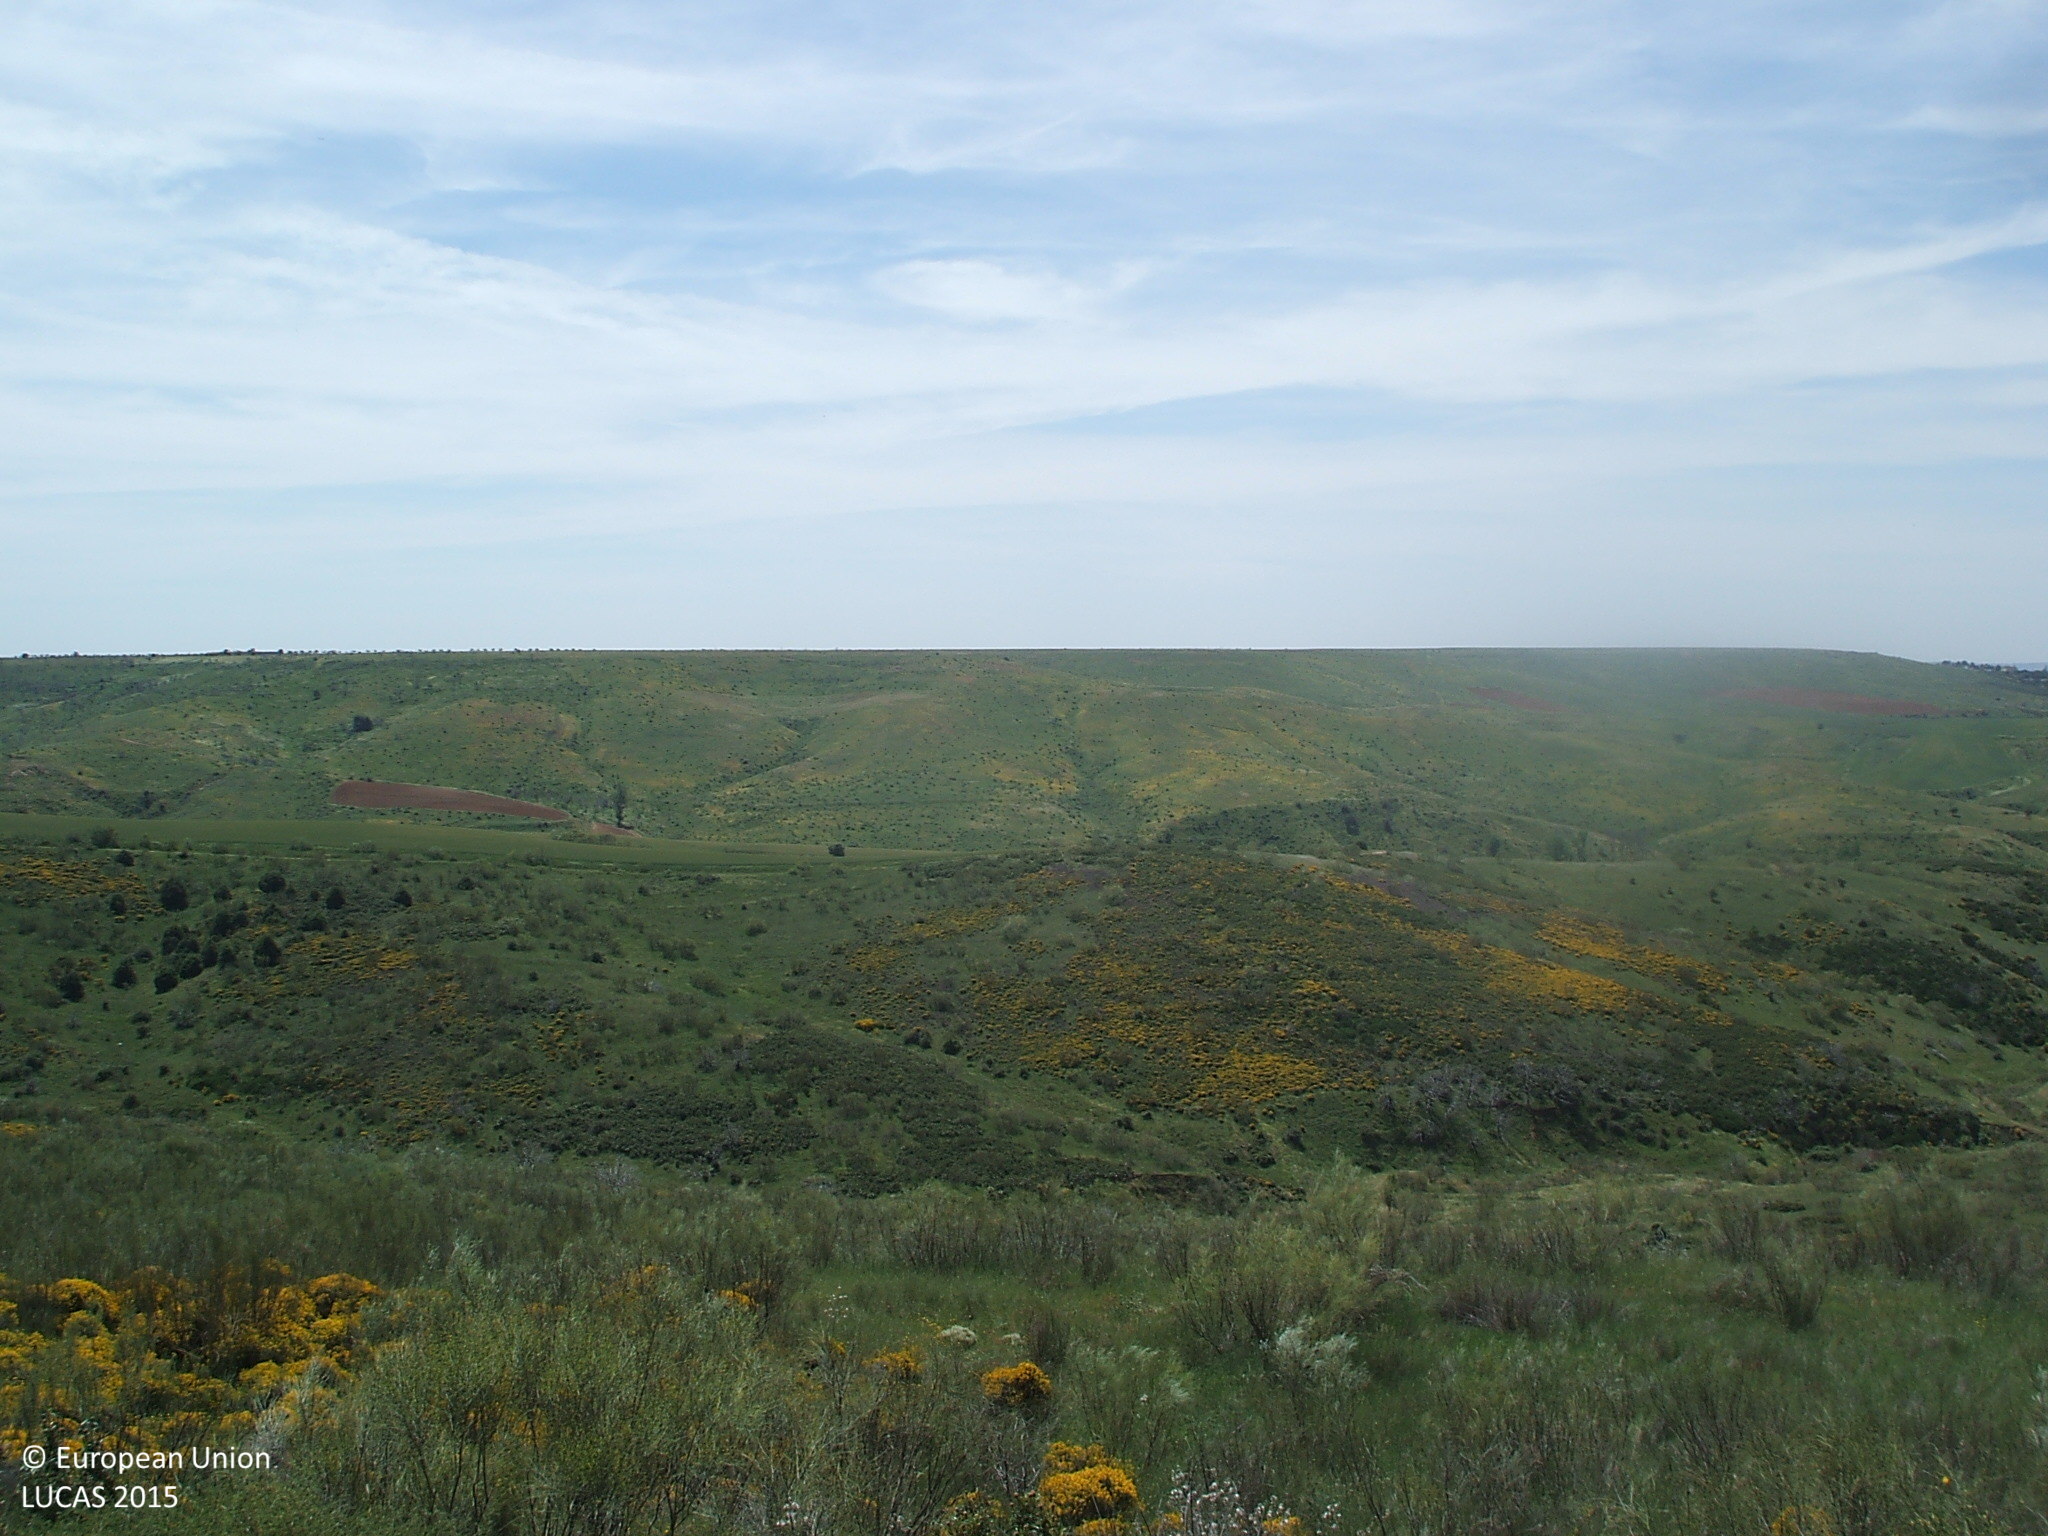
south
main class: Shrubland
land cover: Shrubland without tree cover
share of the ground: > 75 %
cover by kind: shrubs 85 %, herbaceous plants 10 %, consolidated bare surface 5 %
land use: Semi-natural and natural areas not in use
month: May
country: ES
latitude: 40.8197
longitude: -3.4487
